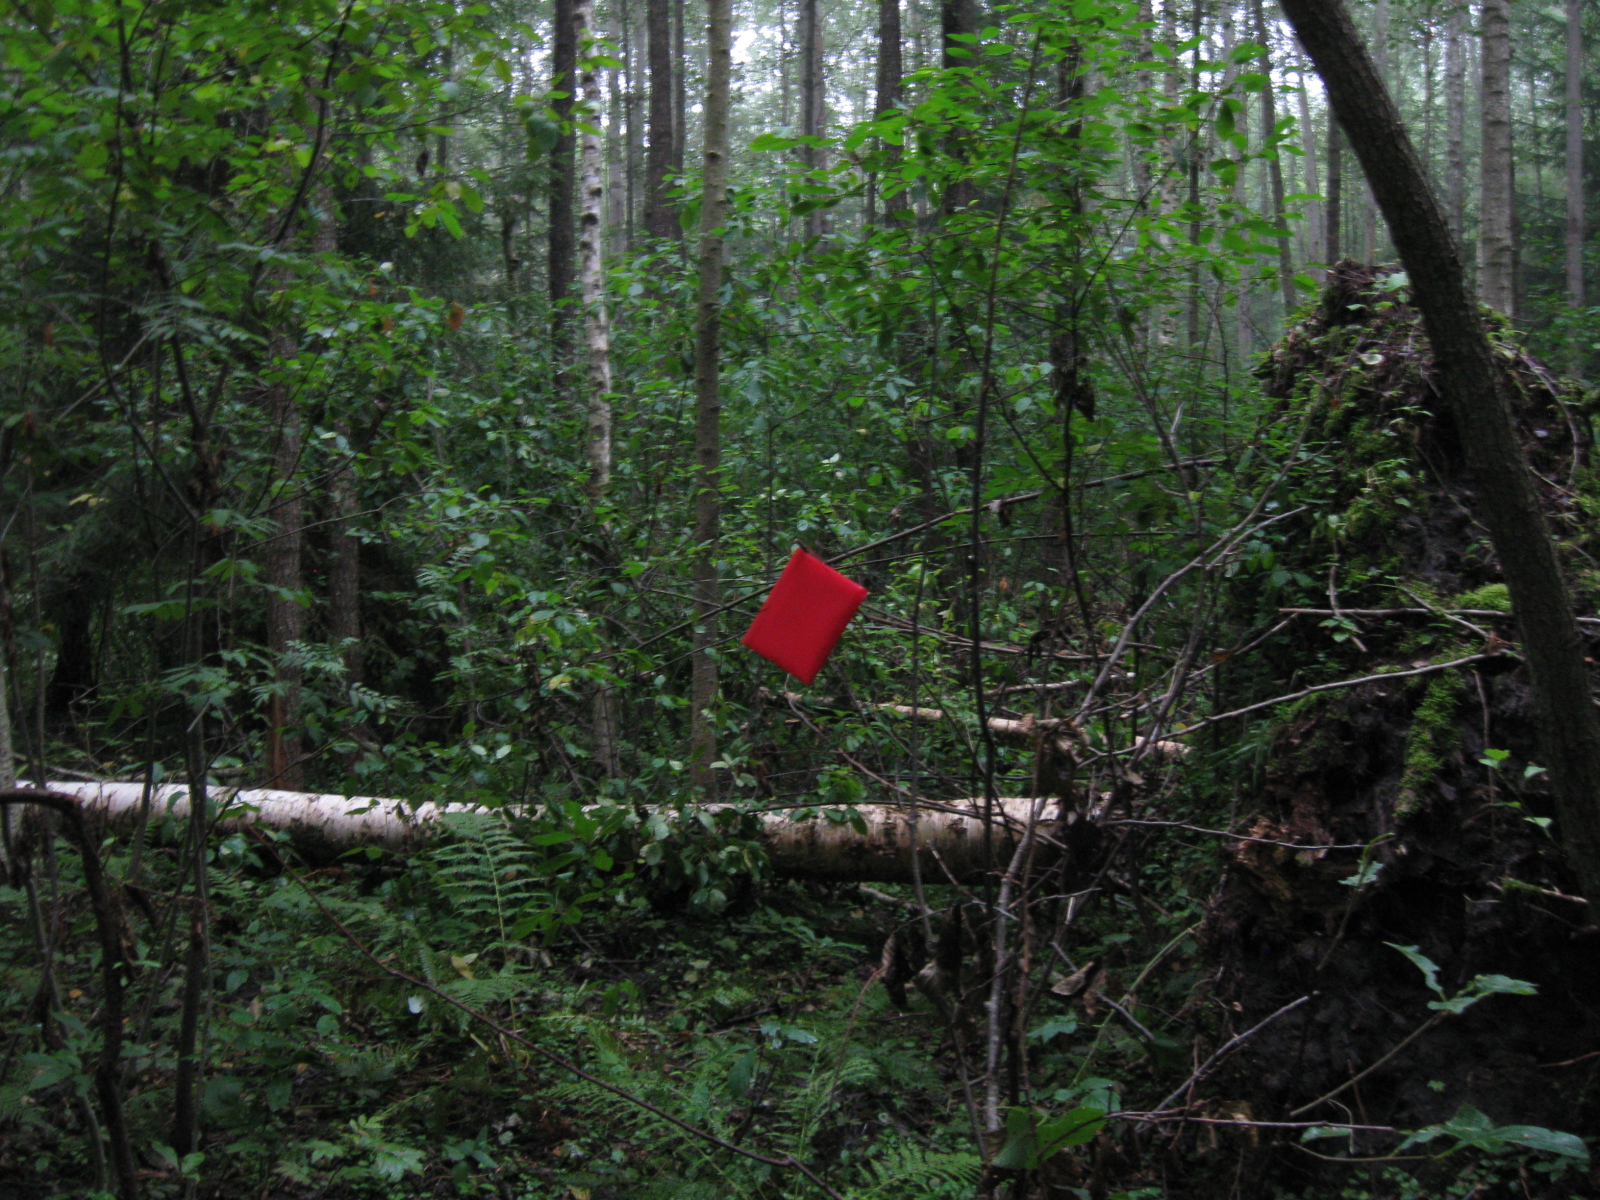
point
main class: Woodland
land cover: Broadleaved woodland
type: non-riverine alder, birch or aspen forest
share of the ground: > 75 %
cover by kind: broadleaved forest trees 85 %, coniferous forest trees 5 %, shrubs 5 %, herbaceous plants 5 %
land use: Forestry
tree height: > 5 m
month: August
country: LT
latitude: 54.7454
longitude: 23.6143
